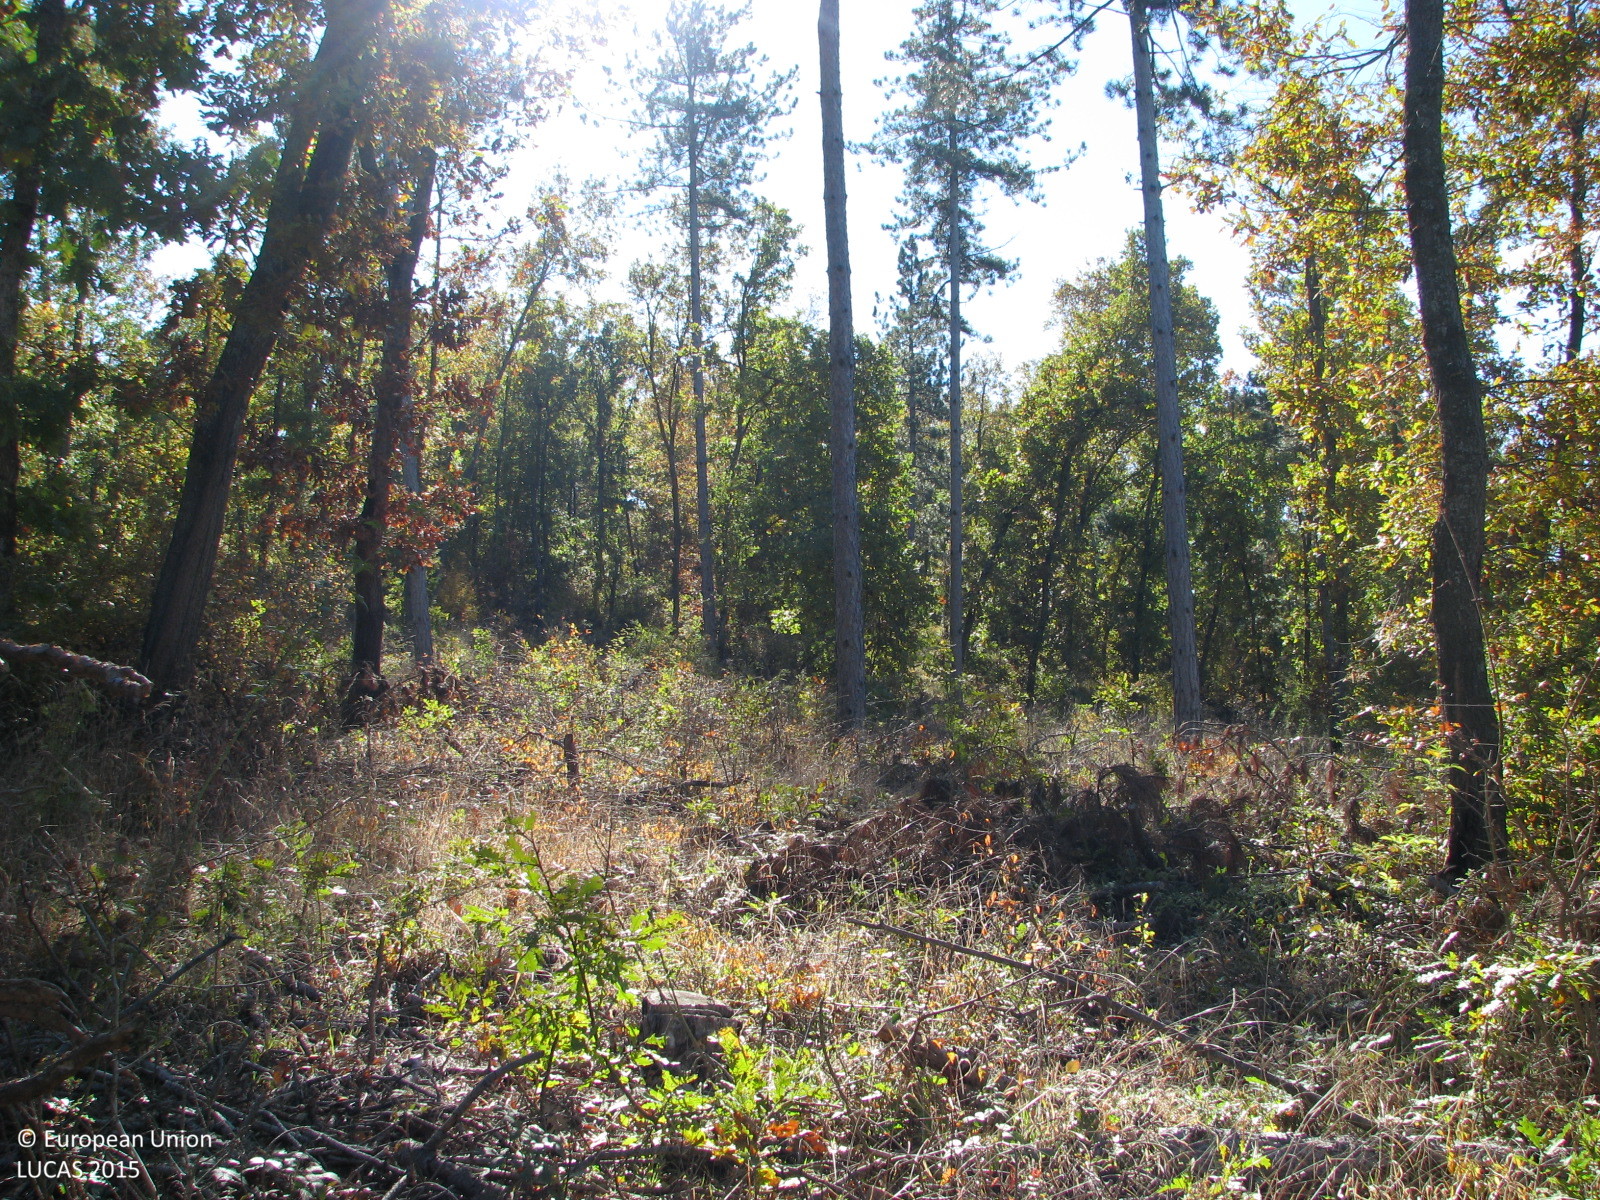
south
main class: Woodland
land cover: Pine dominated mixed woodland
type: hemiboreal forest and nemoral coniferous forest and mixed broadleaved-coniferous forest
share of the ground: 25 - 50 %
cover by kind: herbaceous plants 40 %, coniferous forest trees 30 %, broadleaved forest trees 20 %, shrubs 10 %
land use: Forestry
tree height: > 5 m
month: November
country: BG
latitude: 41.9901
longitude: 26.7123
